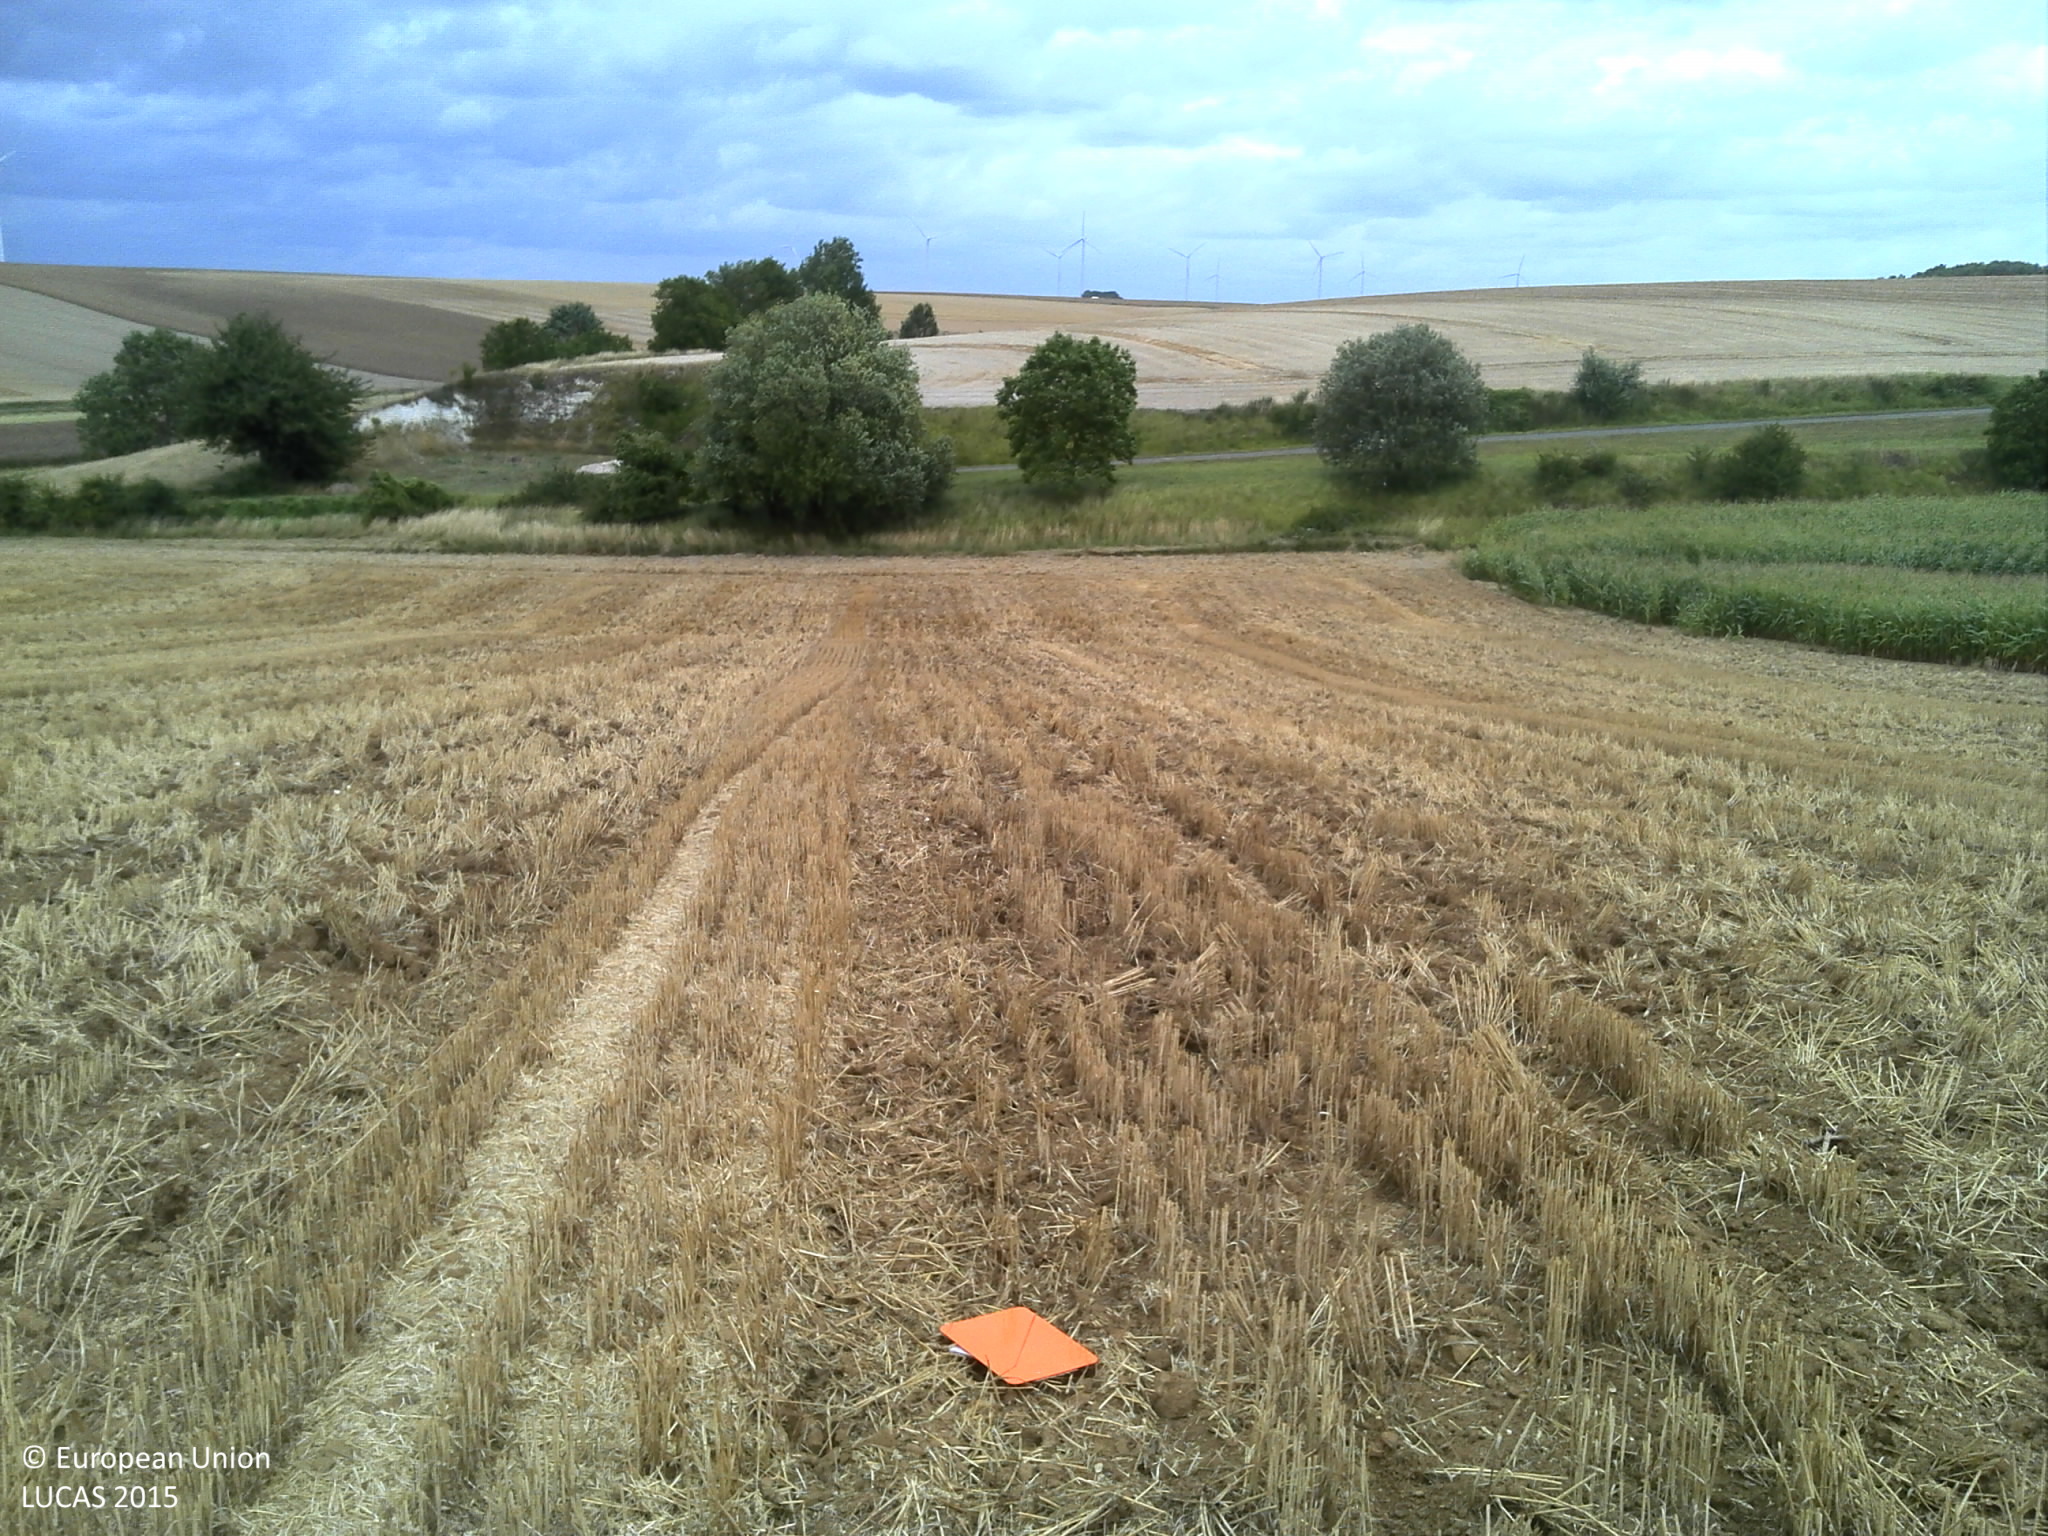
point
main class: Cropland
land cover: Common wheat
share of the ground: 50 - 75 %
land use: Agriculture (excluding fallow land and kitchen gardens)
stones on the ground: < 10 %
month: July
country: FR
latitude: 49.6174
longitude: 4.1125
